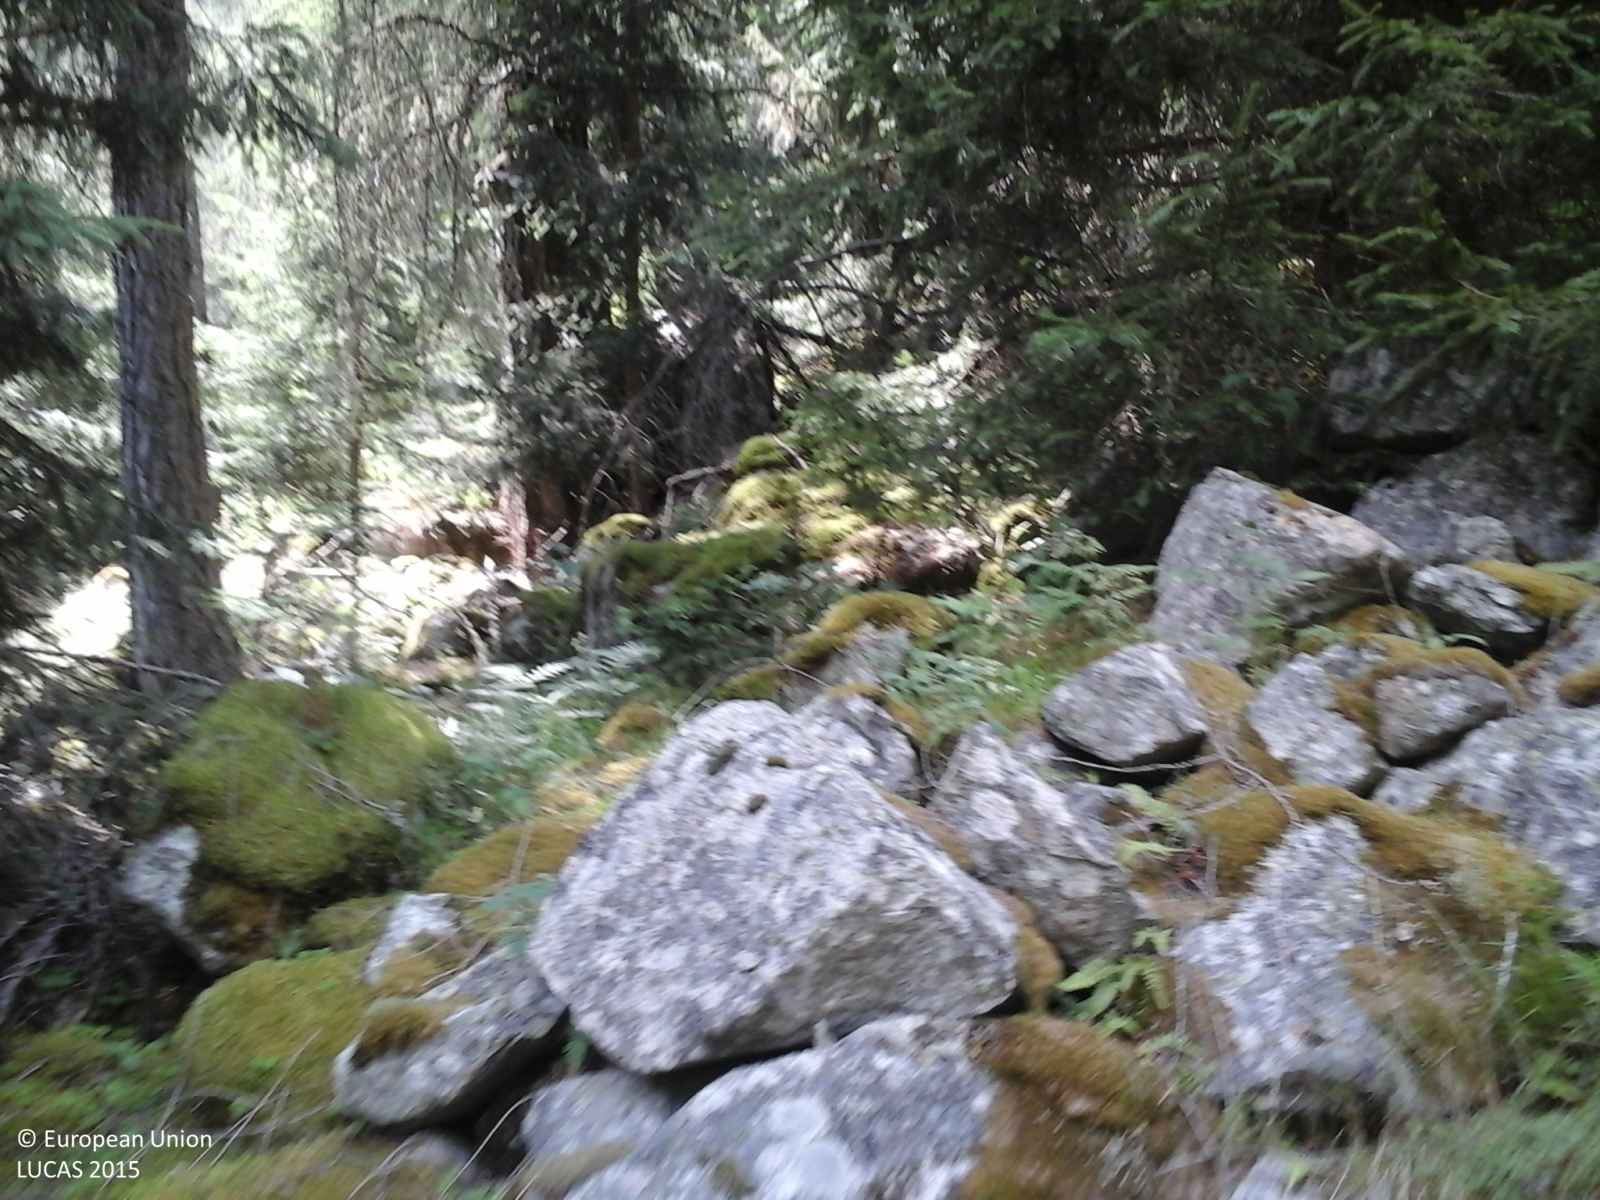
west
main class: Woodland
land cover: Spruce dominated coniferous woodland
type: alpine coniferous forest
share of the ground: > 75 %
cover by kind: coniferous forest trees 100 %
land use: Semi-natural and natural areas not in use
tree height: > 5 m
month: July
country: IT
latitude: 46.8614
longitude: 11.6118
